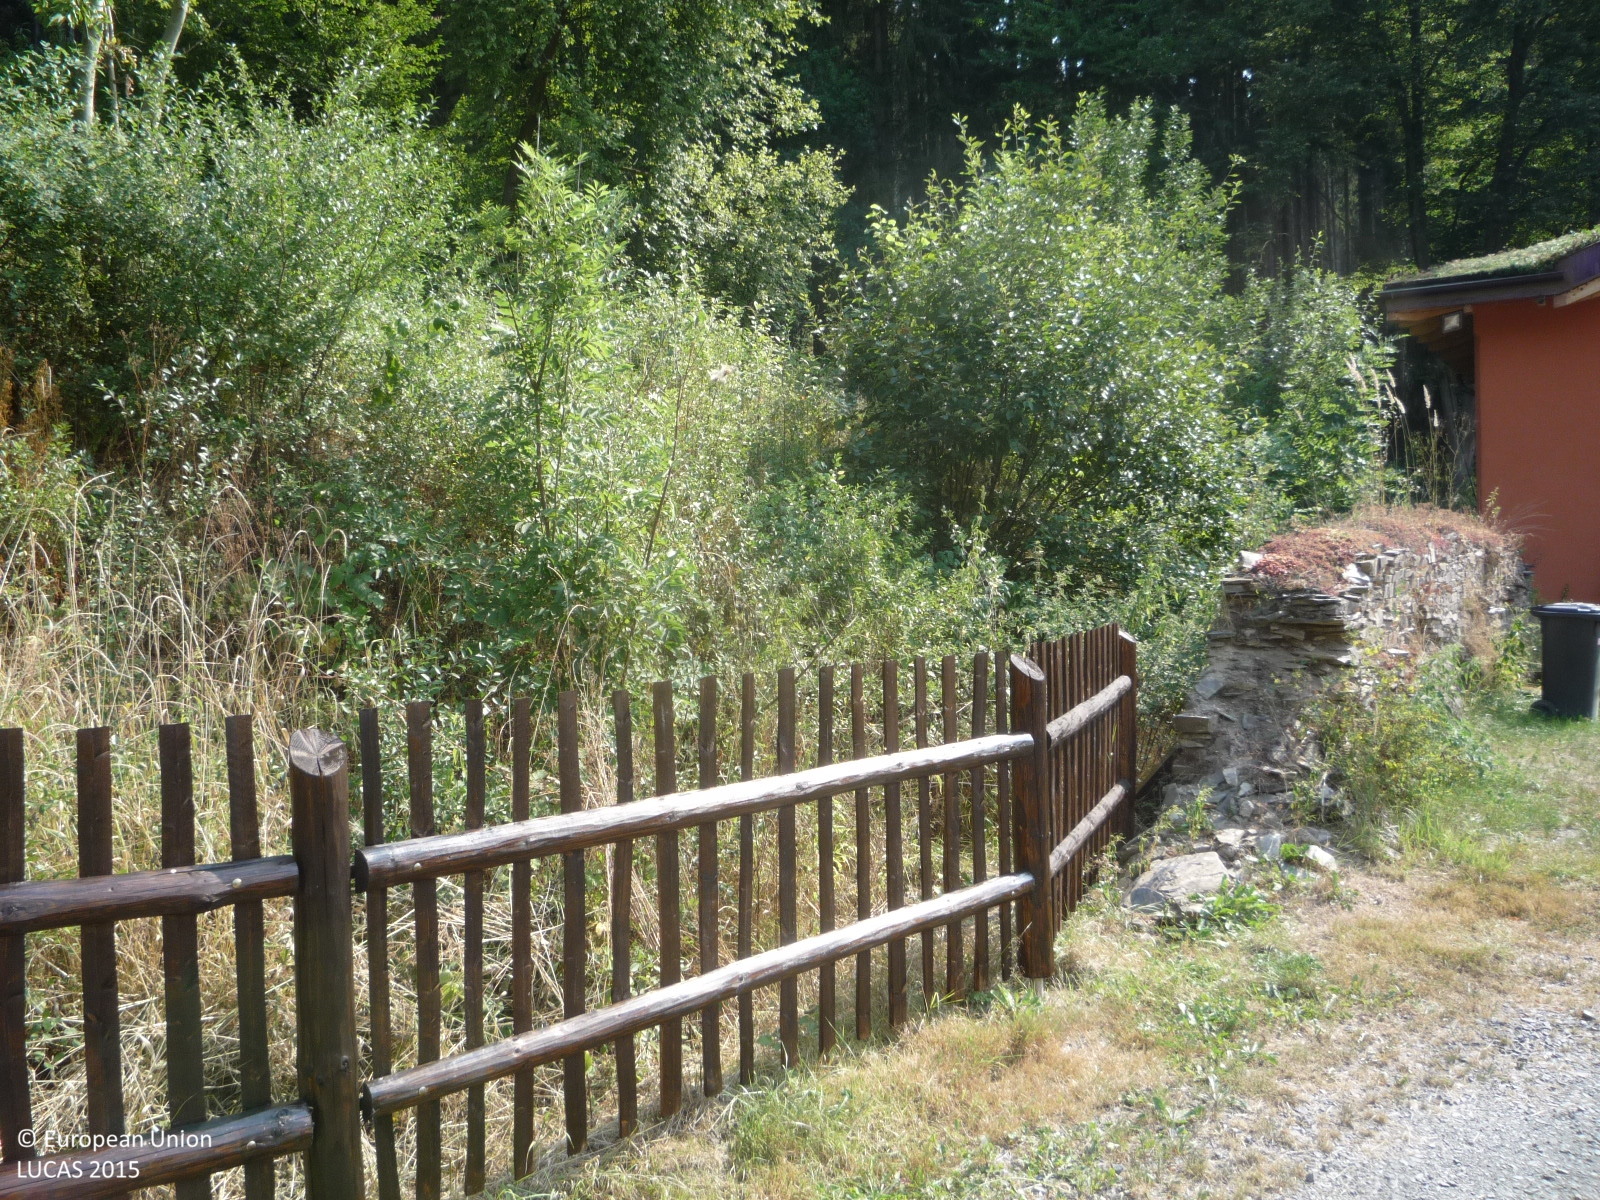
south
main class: Grassland
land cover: Spontaneously vegetated surfaces
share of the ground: > 75 %
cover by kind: herbaceous plants 100 %
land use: Semi-natural and natural areas not in use
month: August
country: CZ
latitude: 49.9164
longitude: 14.4721
